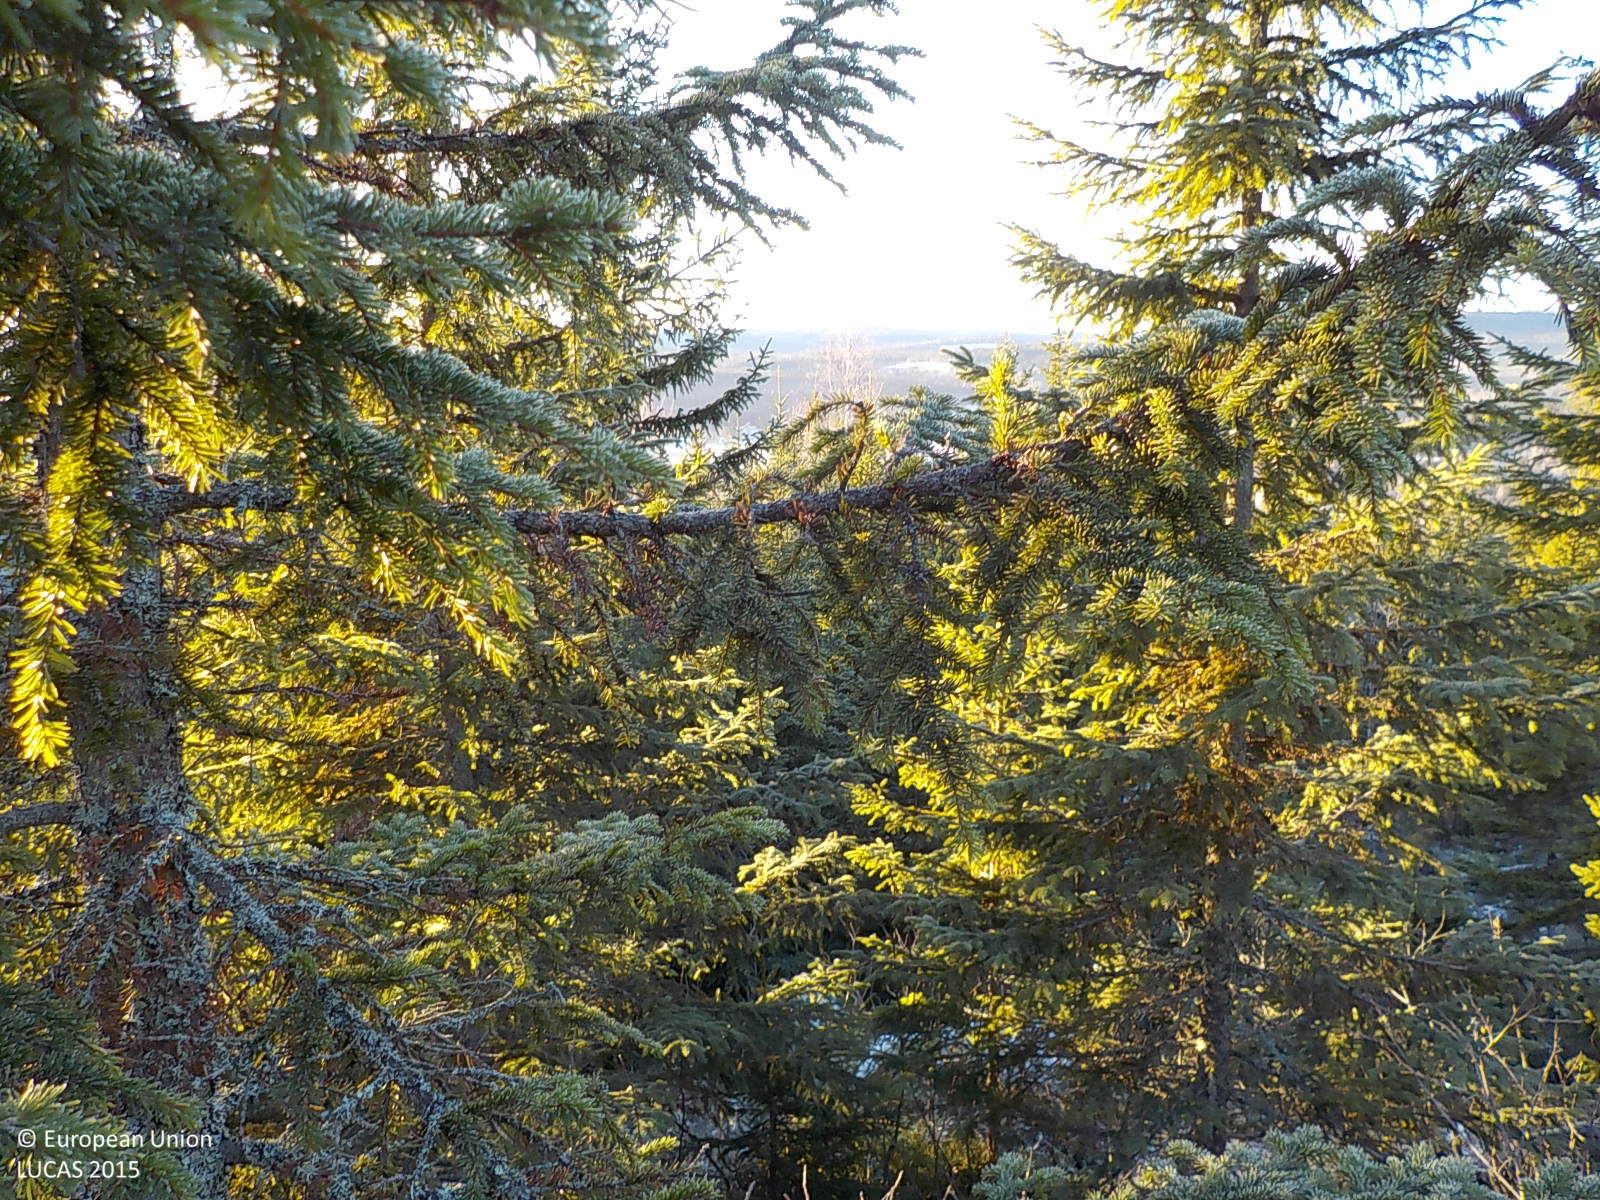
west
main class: Woodland
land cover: Spruce dominated coniferous woodland
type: boreal forest
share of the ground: 50 - 75 %
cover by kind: coniferous forest trees 60 %, shrubs 20 %, herbaceous plants 20 %
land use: Forestry
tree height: < 5 m
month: November
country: SE
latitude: 63.1280
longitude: 18.2870
